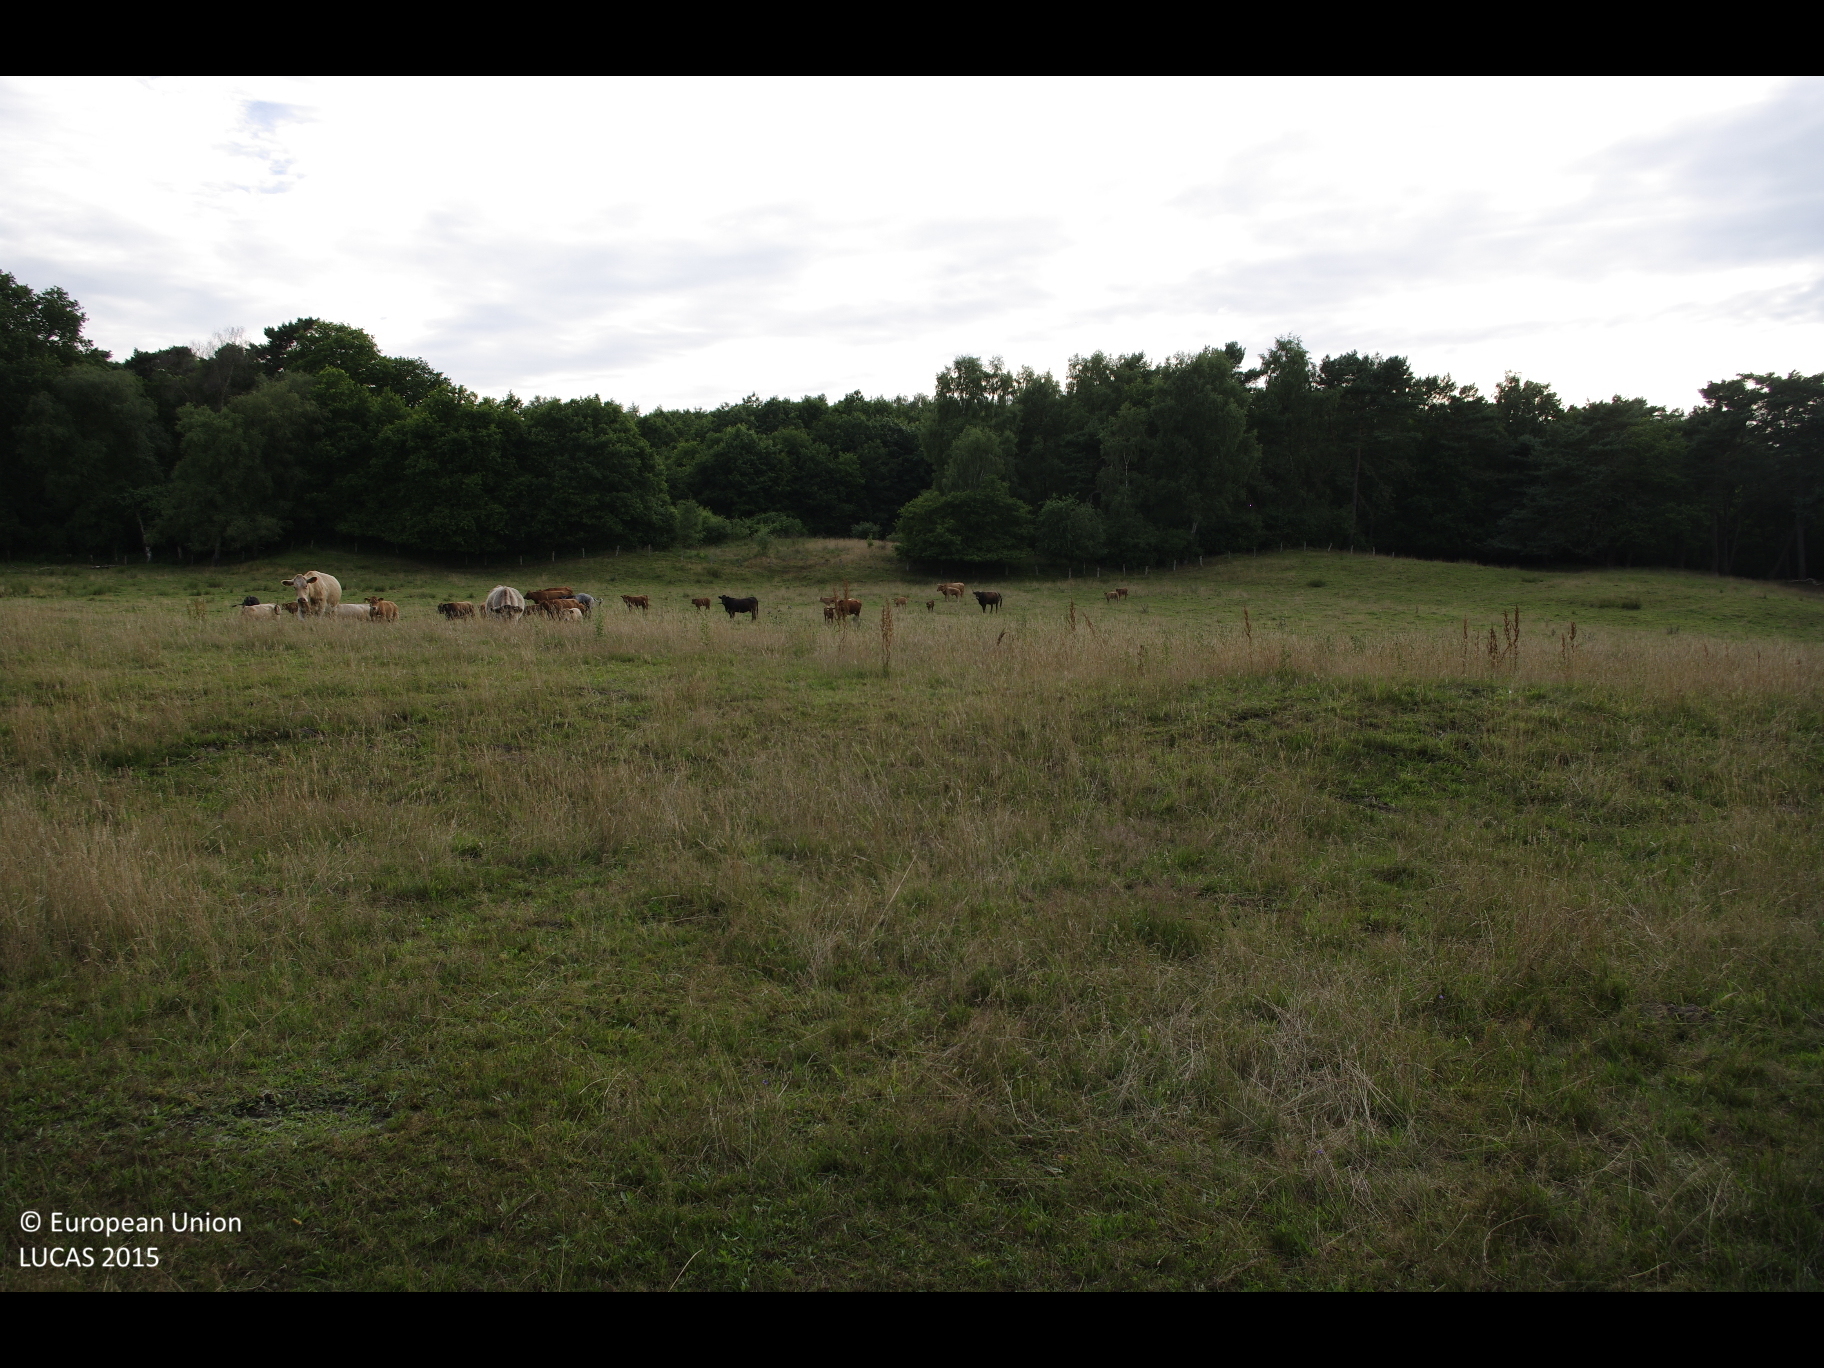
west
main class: Grassland
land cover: Grassland without tree/shrub cover
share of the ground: > 75 %
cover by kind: herbaceous plants 100 %
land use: Agriculture (excluding fallow land and kitchen gardens)
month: July
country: DE
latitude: 53.9411
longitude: 9.9239
